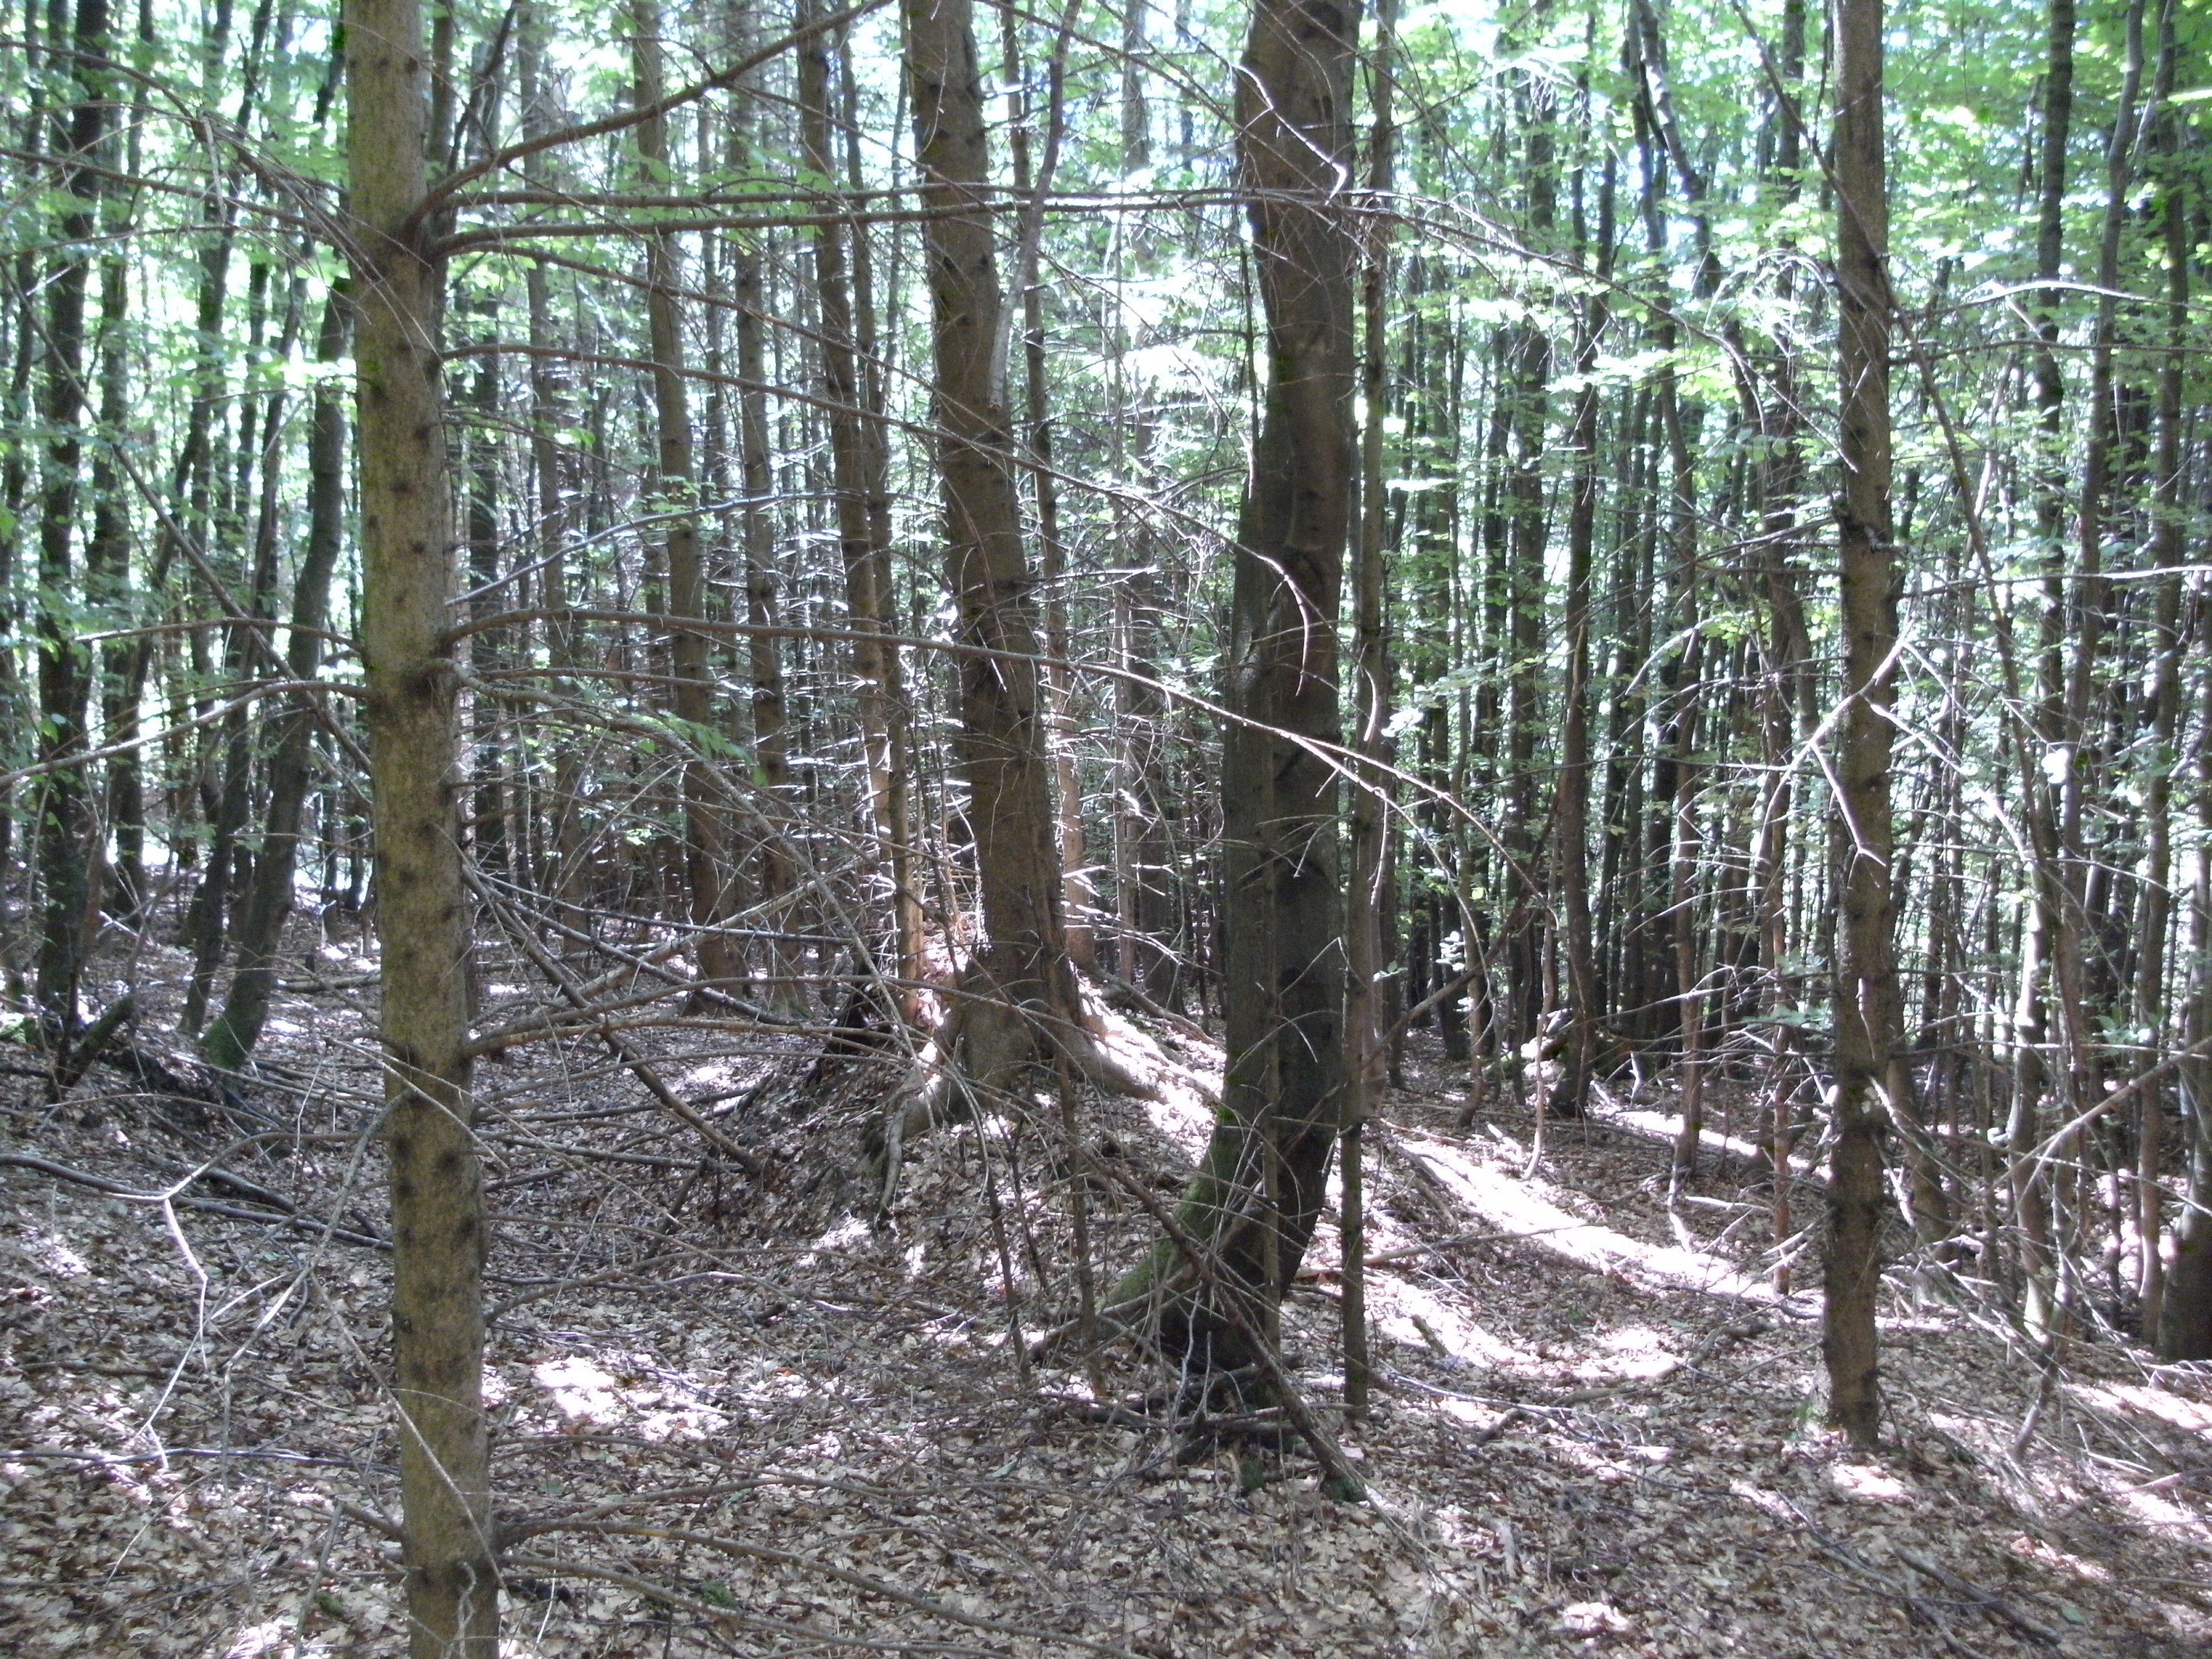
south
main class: Woodland
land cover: Broadleaved woodland
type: beech forest
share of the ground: > 75 %
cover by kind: broadleaved forest trees 85 %, coniferous forest trees 10 %, unconsolidated bare surface 5 %
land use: Forestry
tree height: > 5 m
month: June
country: AT
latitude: 48.0461
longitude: 13.3660
